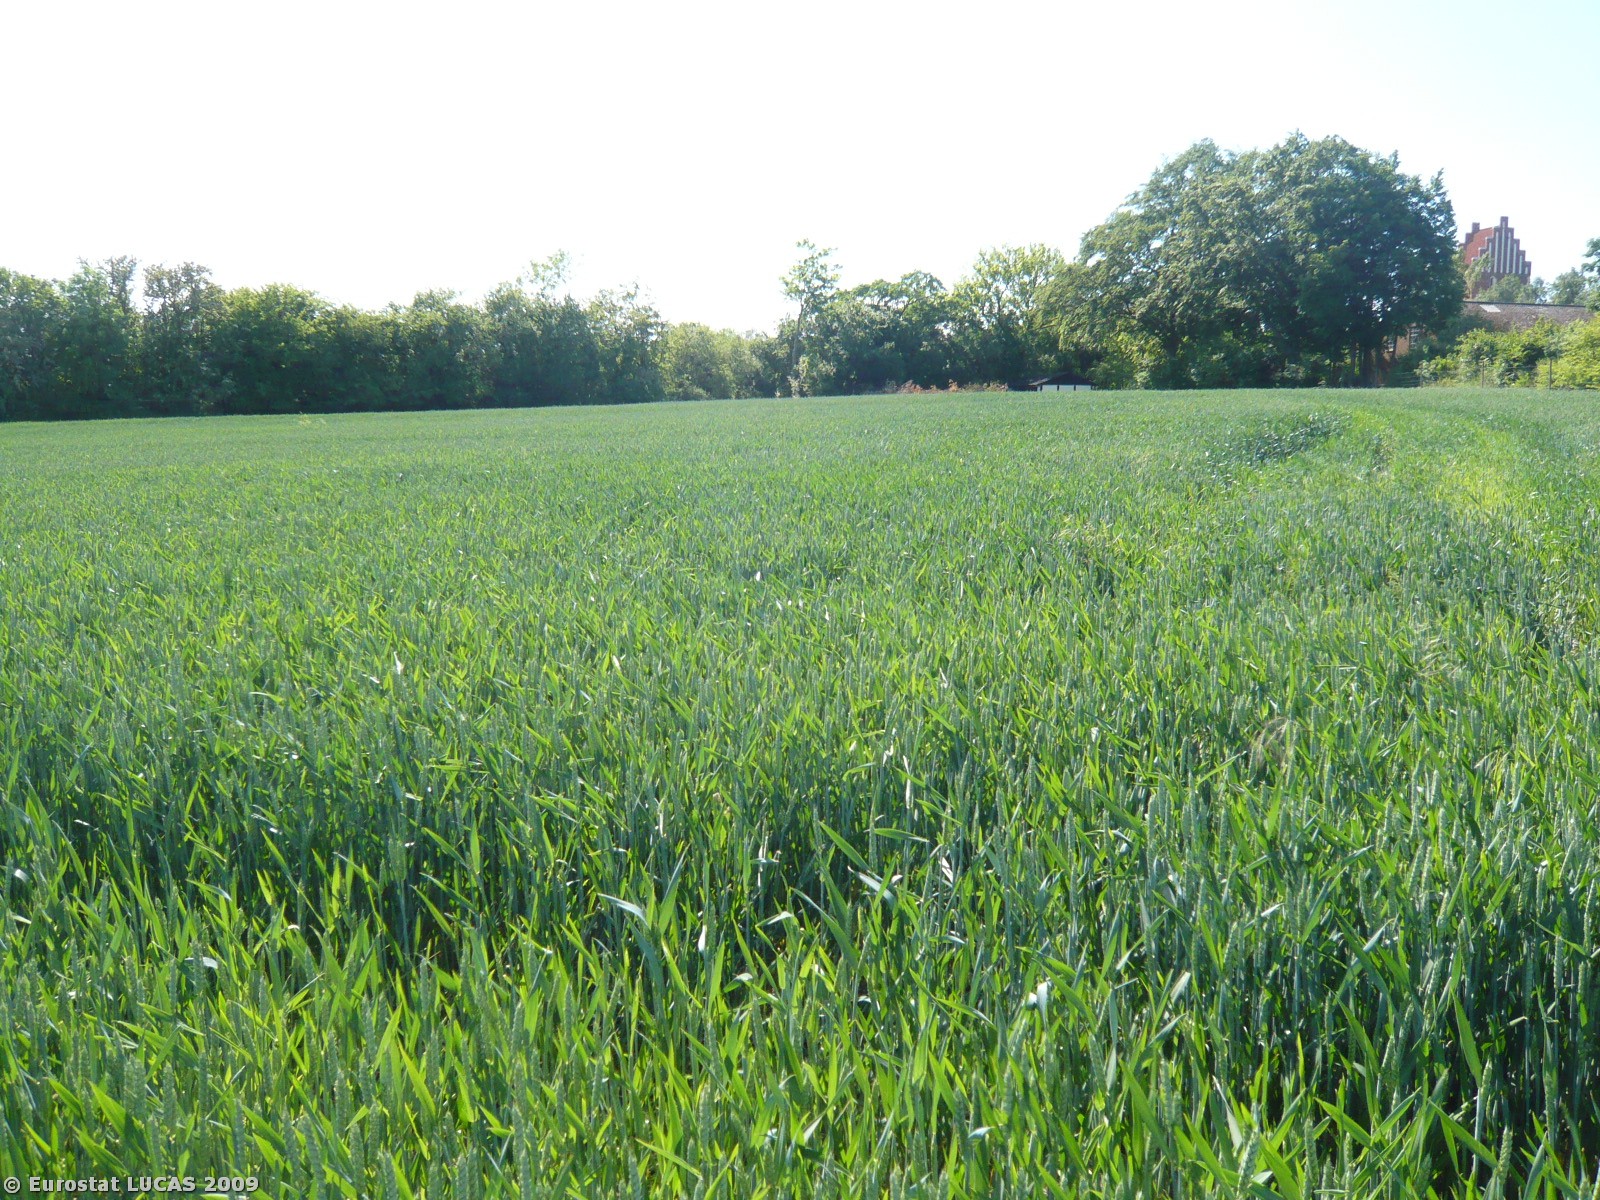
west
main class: Cropland
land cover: Common wheat
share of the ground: > 75 %
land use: Agriculture (excluding fallow land and kitchen gardens)
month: June
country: DK
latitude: 55.3006
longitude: 11.2748
